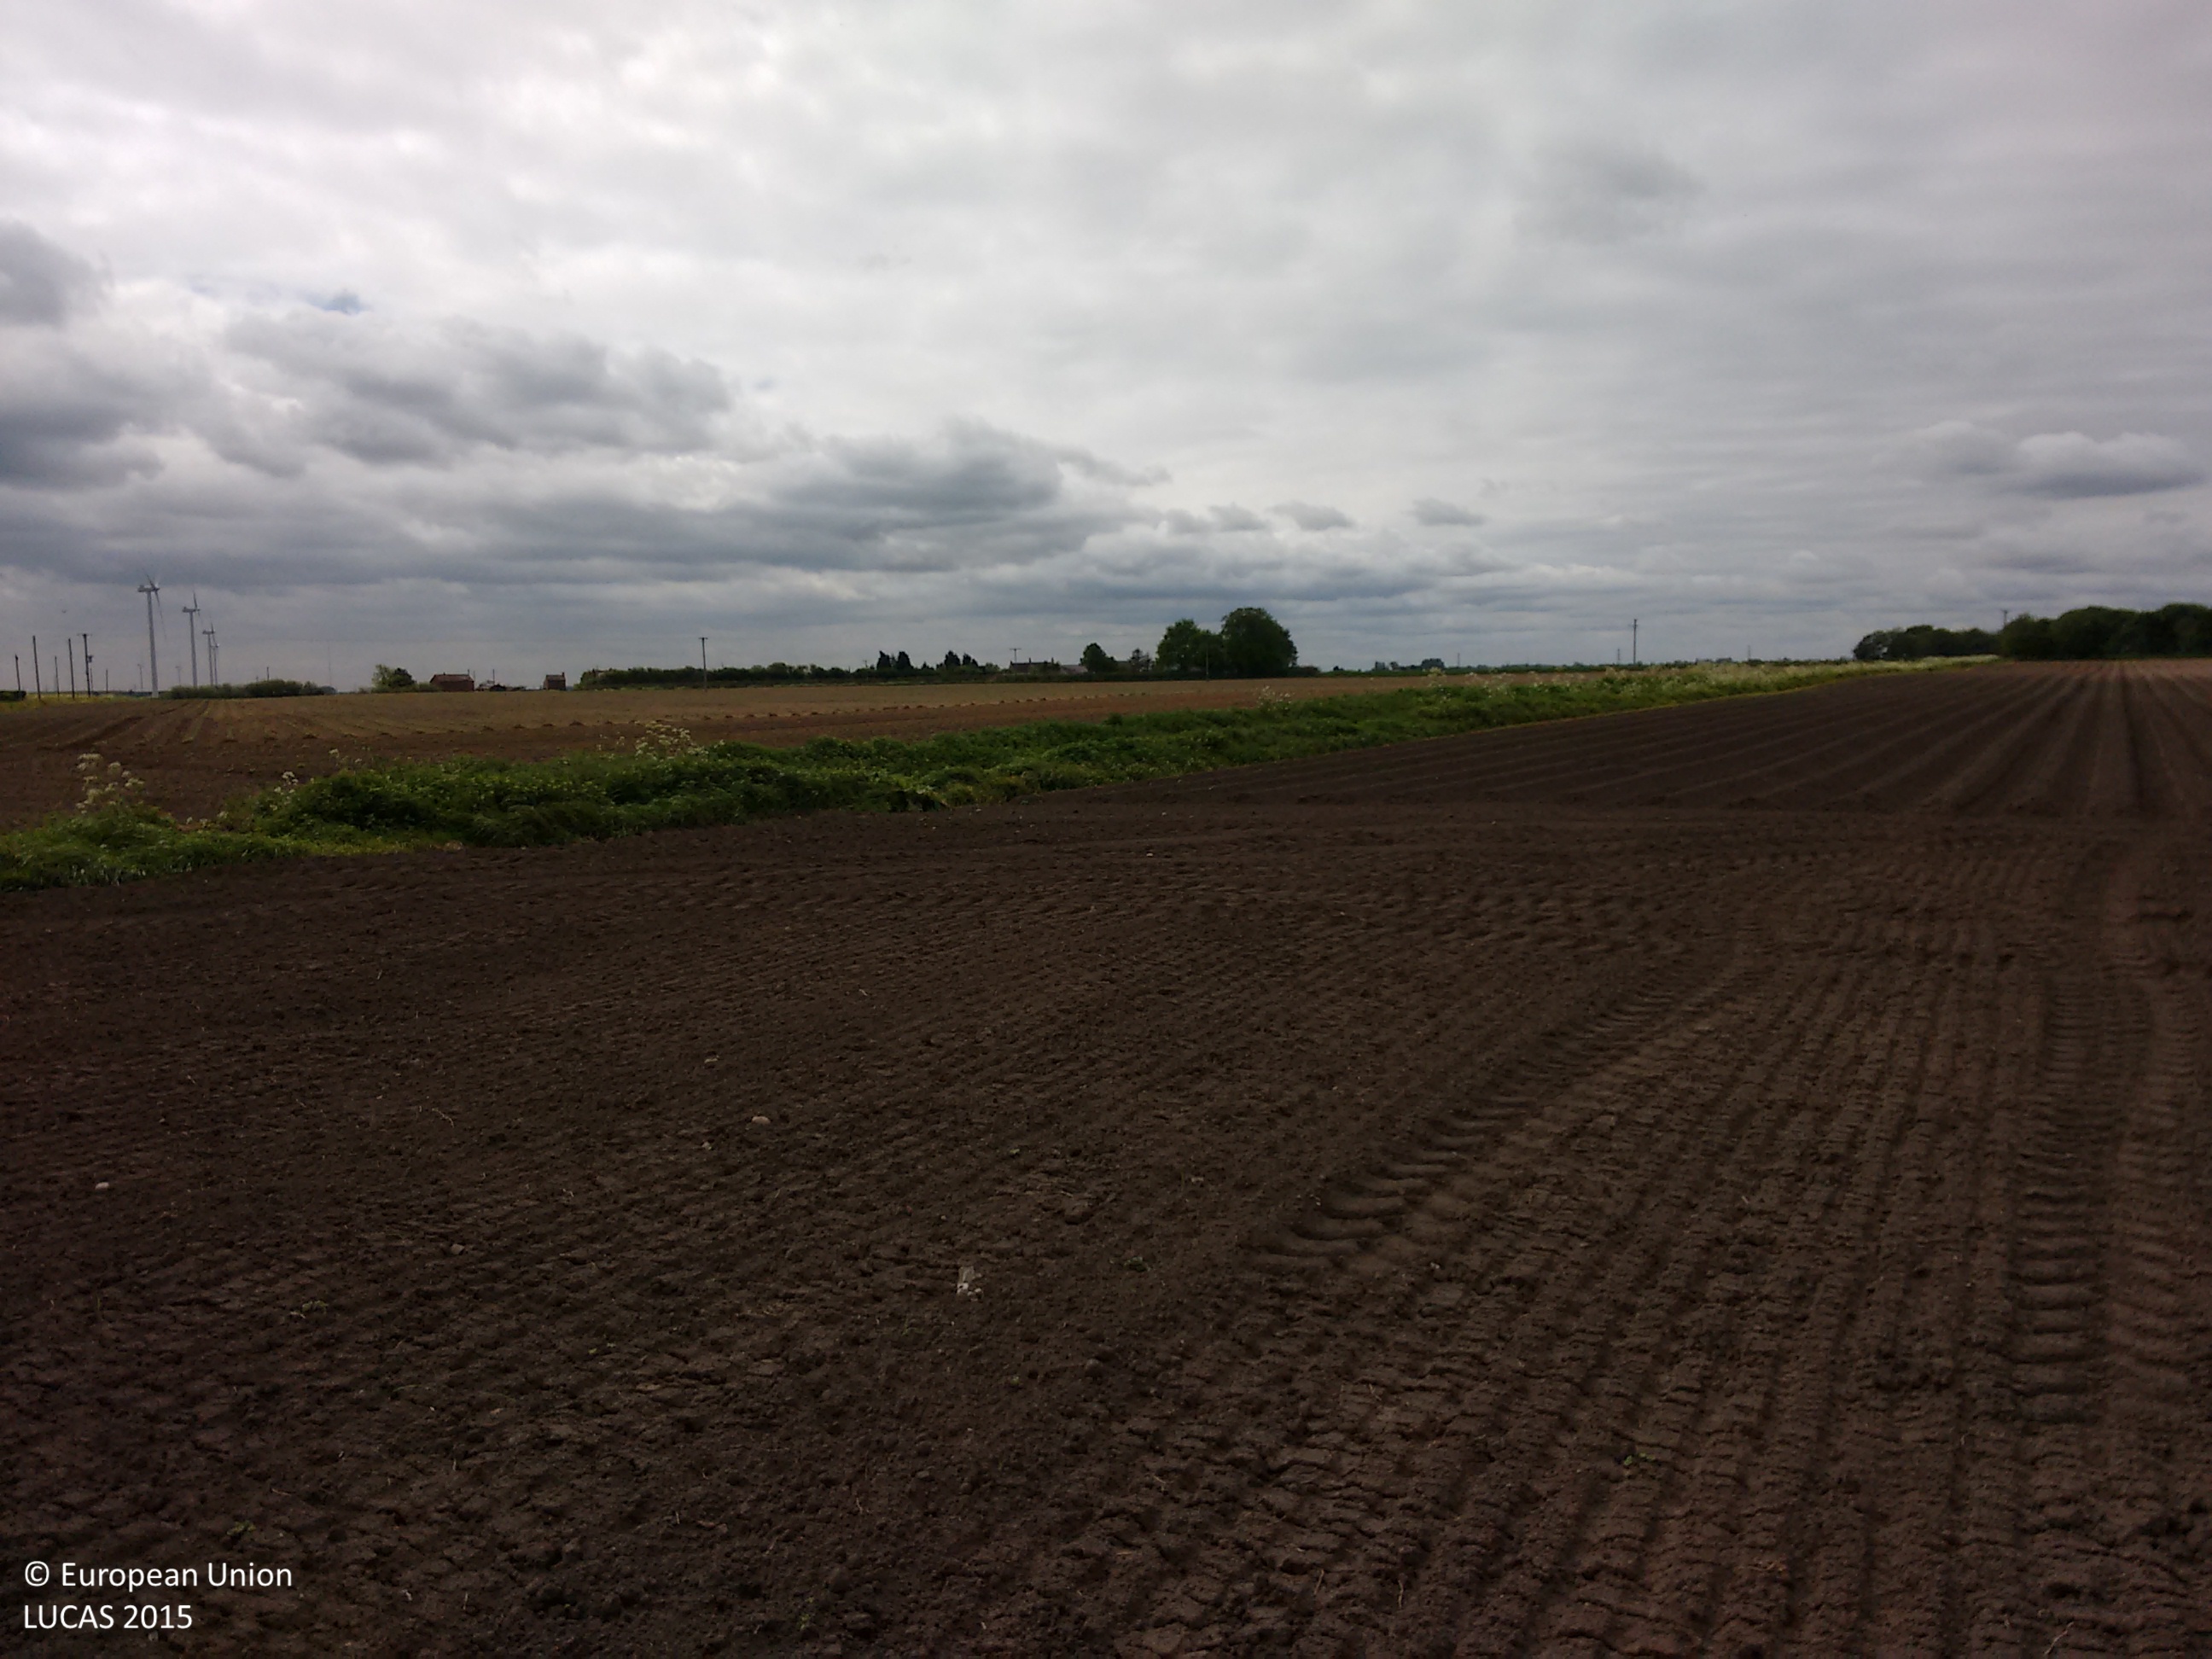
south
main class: Cropland
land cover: Potatoes
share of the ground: < 10 %
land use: Agriculture (excluding fallow land and kitchen gardens)
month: May
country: GB
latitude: 53.6259
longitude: -0.7911
